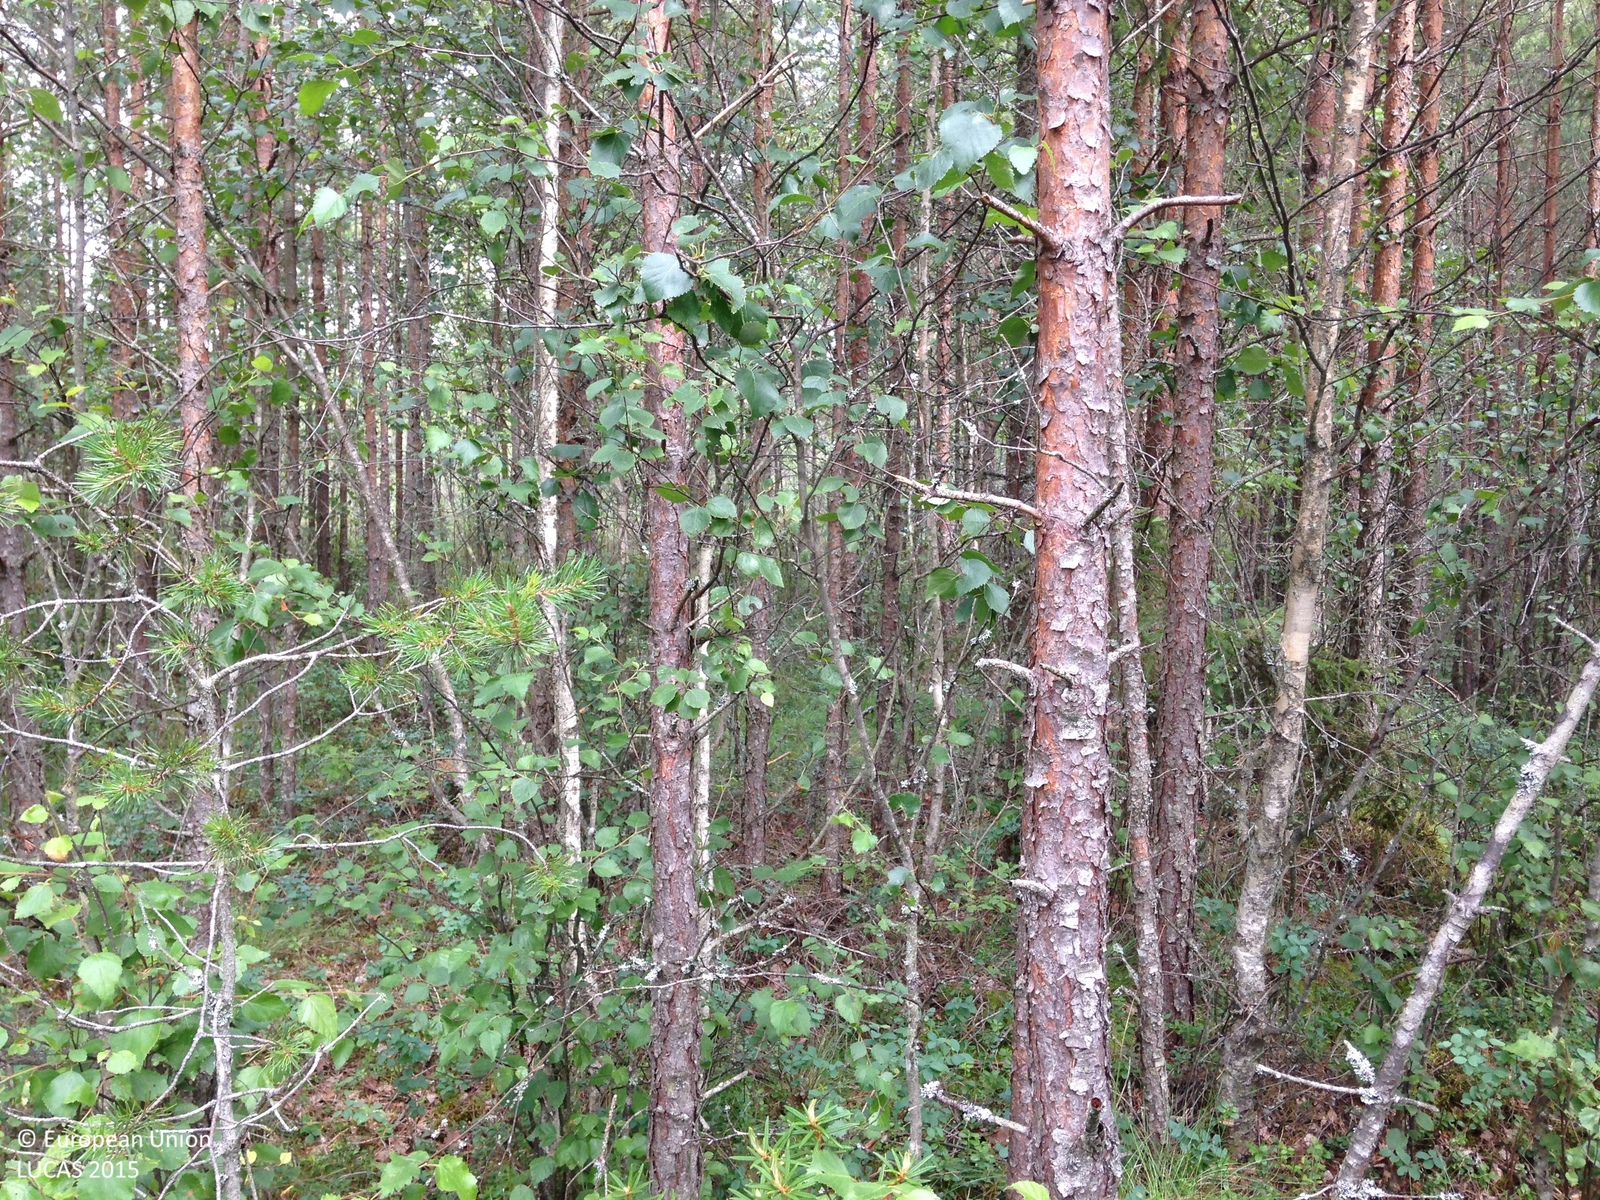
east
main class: Woodland
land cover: Pine dominated coniferous woodland
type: boreal forest
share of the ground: 50 - 75 %
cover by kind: coniferous forest trees 55 %, shrubs 25 %, herbaceous plants 10 %, broadleaved forest trees 5 %, lichens and mosses 5 %
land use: Semi-natural and natural areas not in use
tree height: < 5 m
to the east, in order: Pine dominated coniferous woodland; Ditches and canals; Pine dominated coniferous woodland
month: July
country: SE
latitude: 58.9889
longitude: 14.5690
